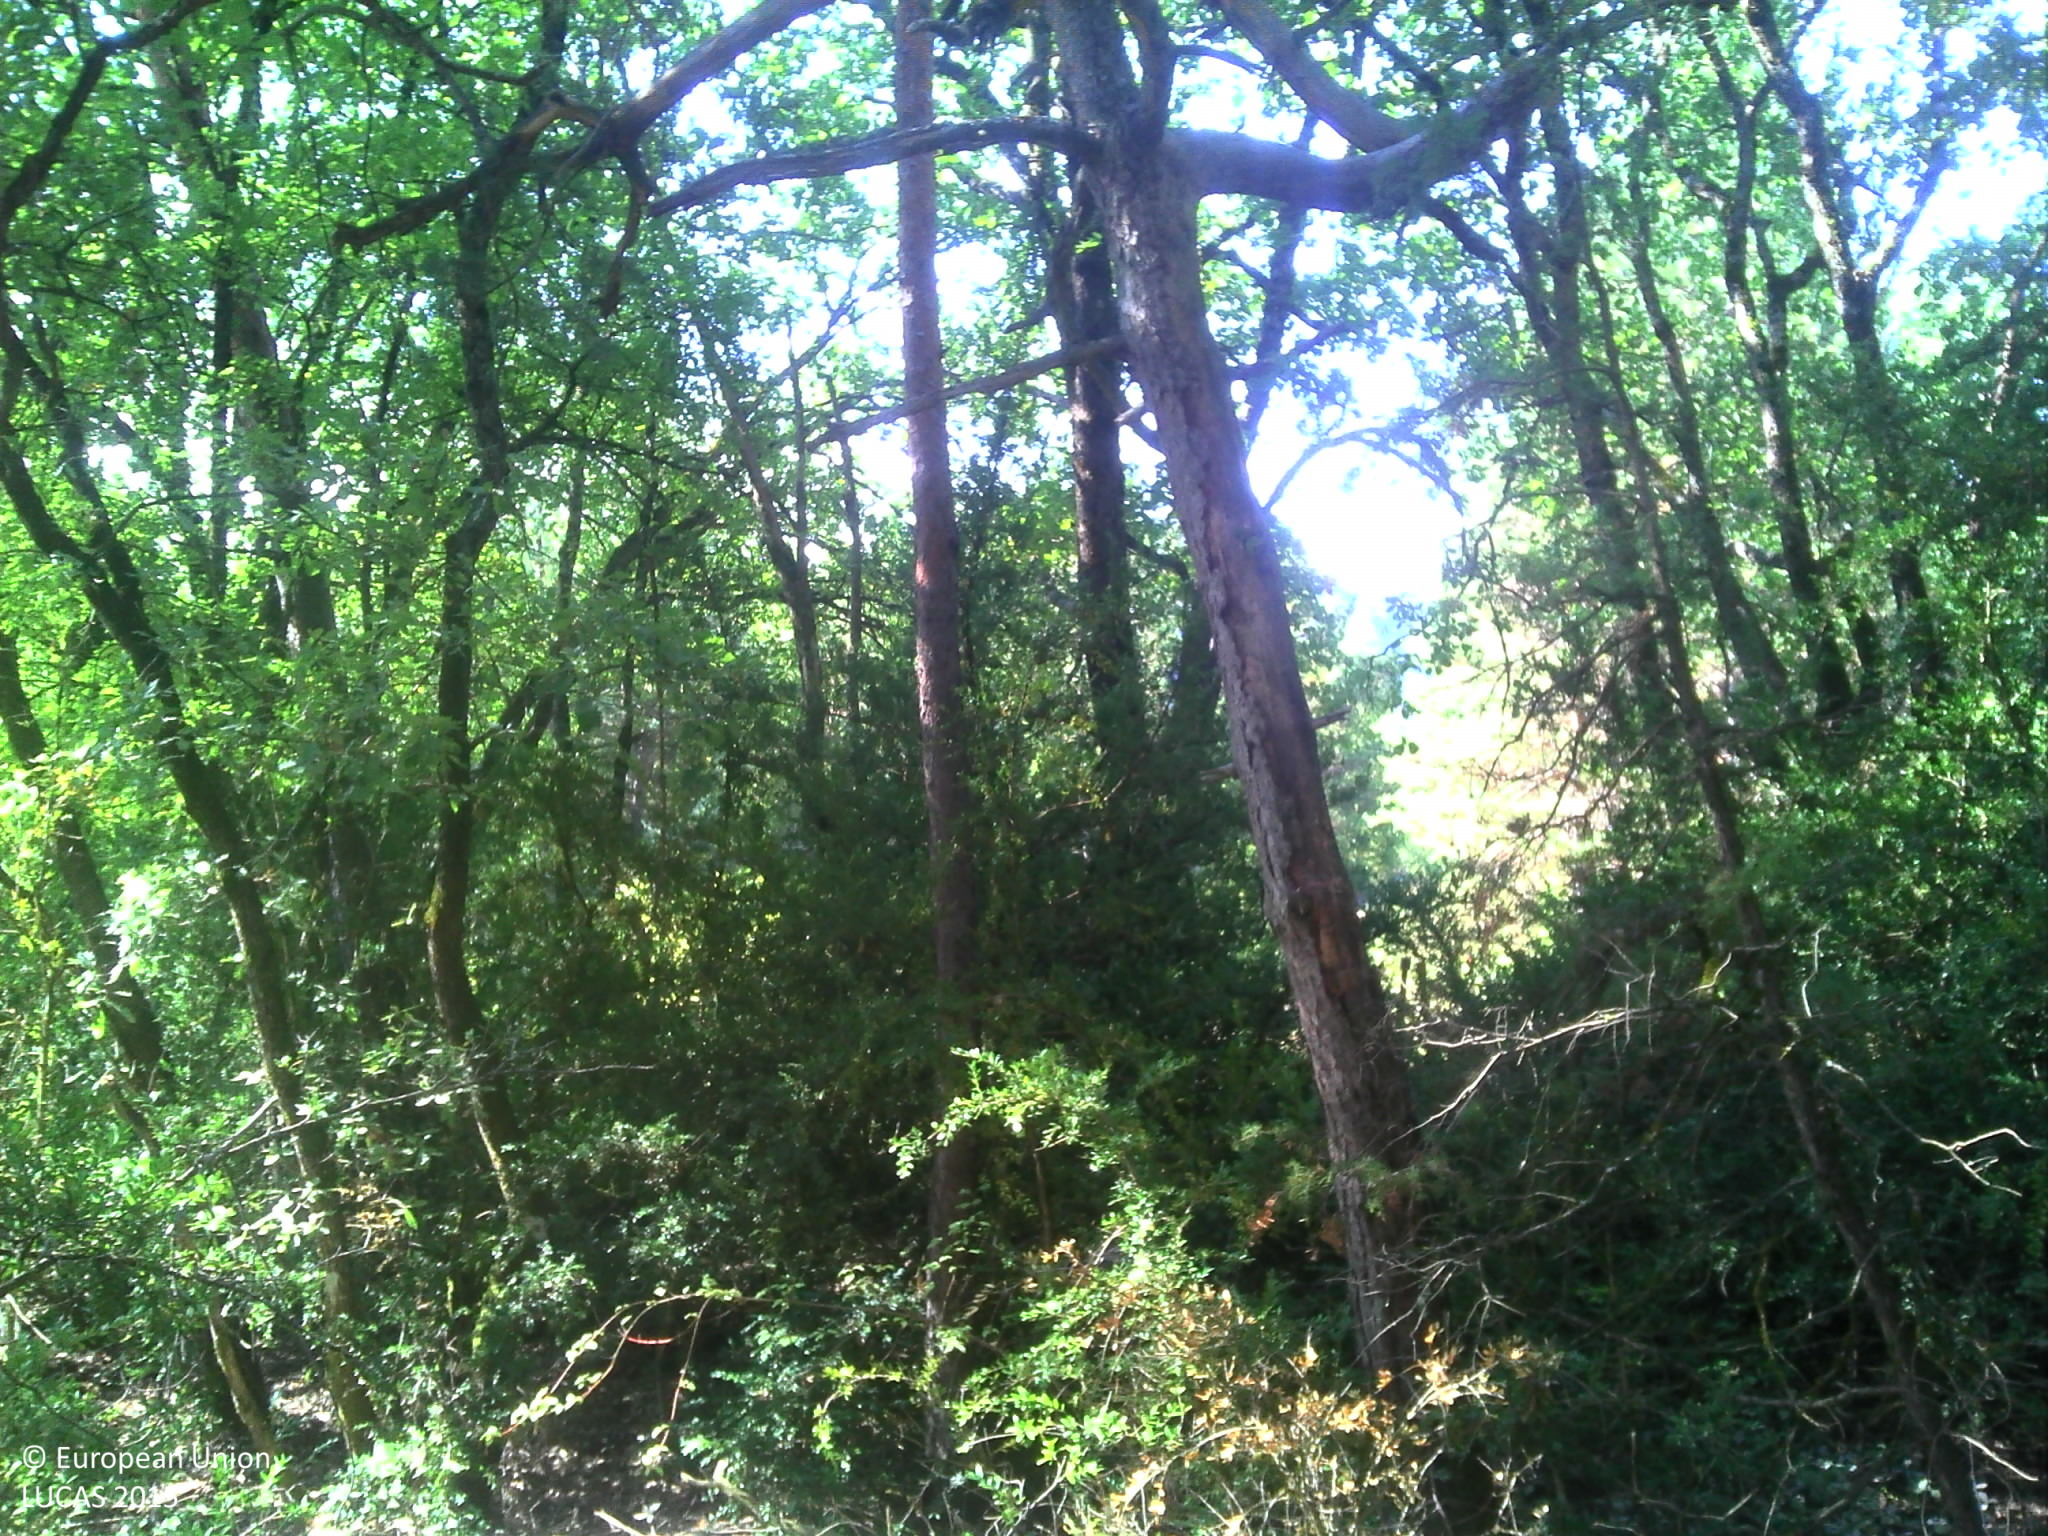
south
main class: Woodland
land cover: Pine dominated mixed woodland
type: alpine coniferous forest
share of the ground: > 75 %
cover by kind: coniferous forest trees 40 %, broadleaved forest trees 20 %, shrubs 20 %, herbaceous plants 20 %
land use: Forestry
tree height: > 5 m
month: August
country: FR
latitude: 44.1391
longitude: 6.2698
